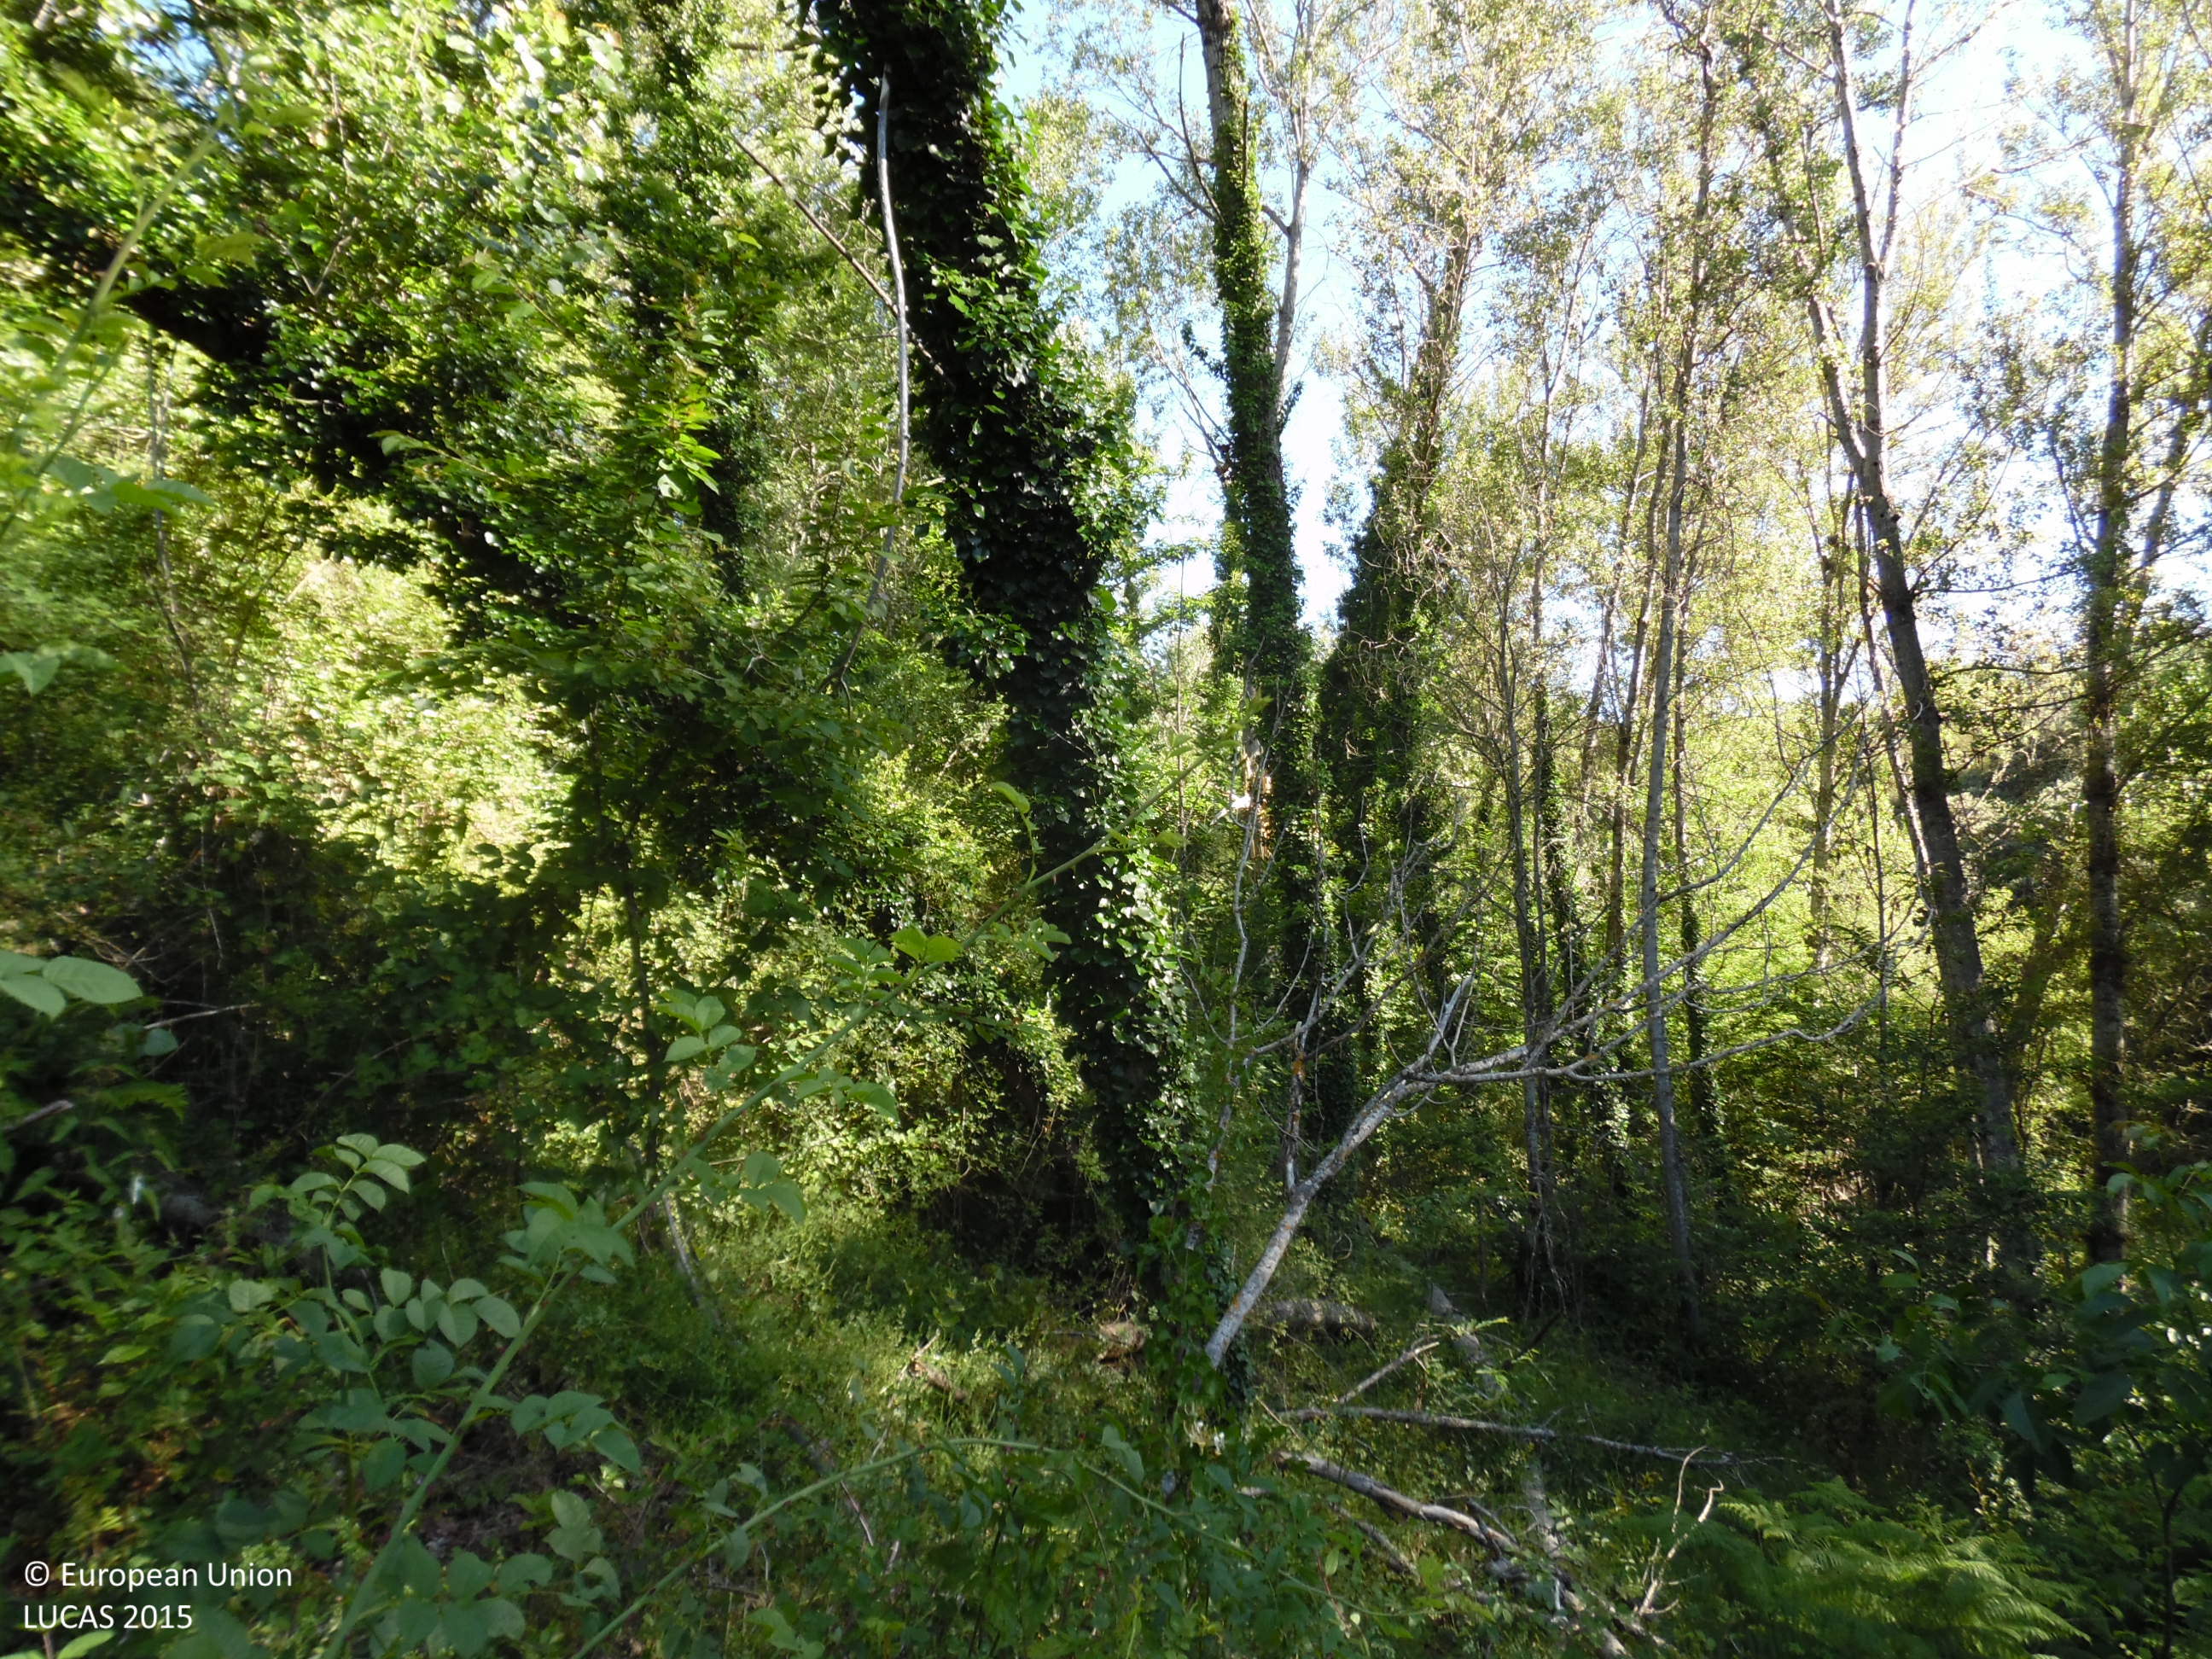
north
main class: Woodland
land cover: Broadleaved woodland
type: thermophilous deciduous forest
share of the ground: > 75 %
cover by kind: broadleaved forest trees 95 %, shrubs 5 %
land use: Forestry
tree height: > 5 m
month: June
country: ES
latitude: 42.6247
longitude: -6.7680
